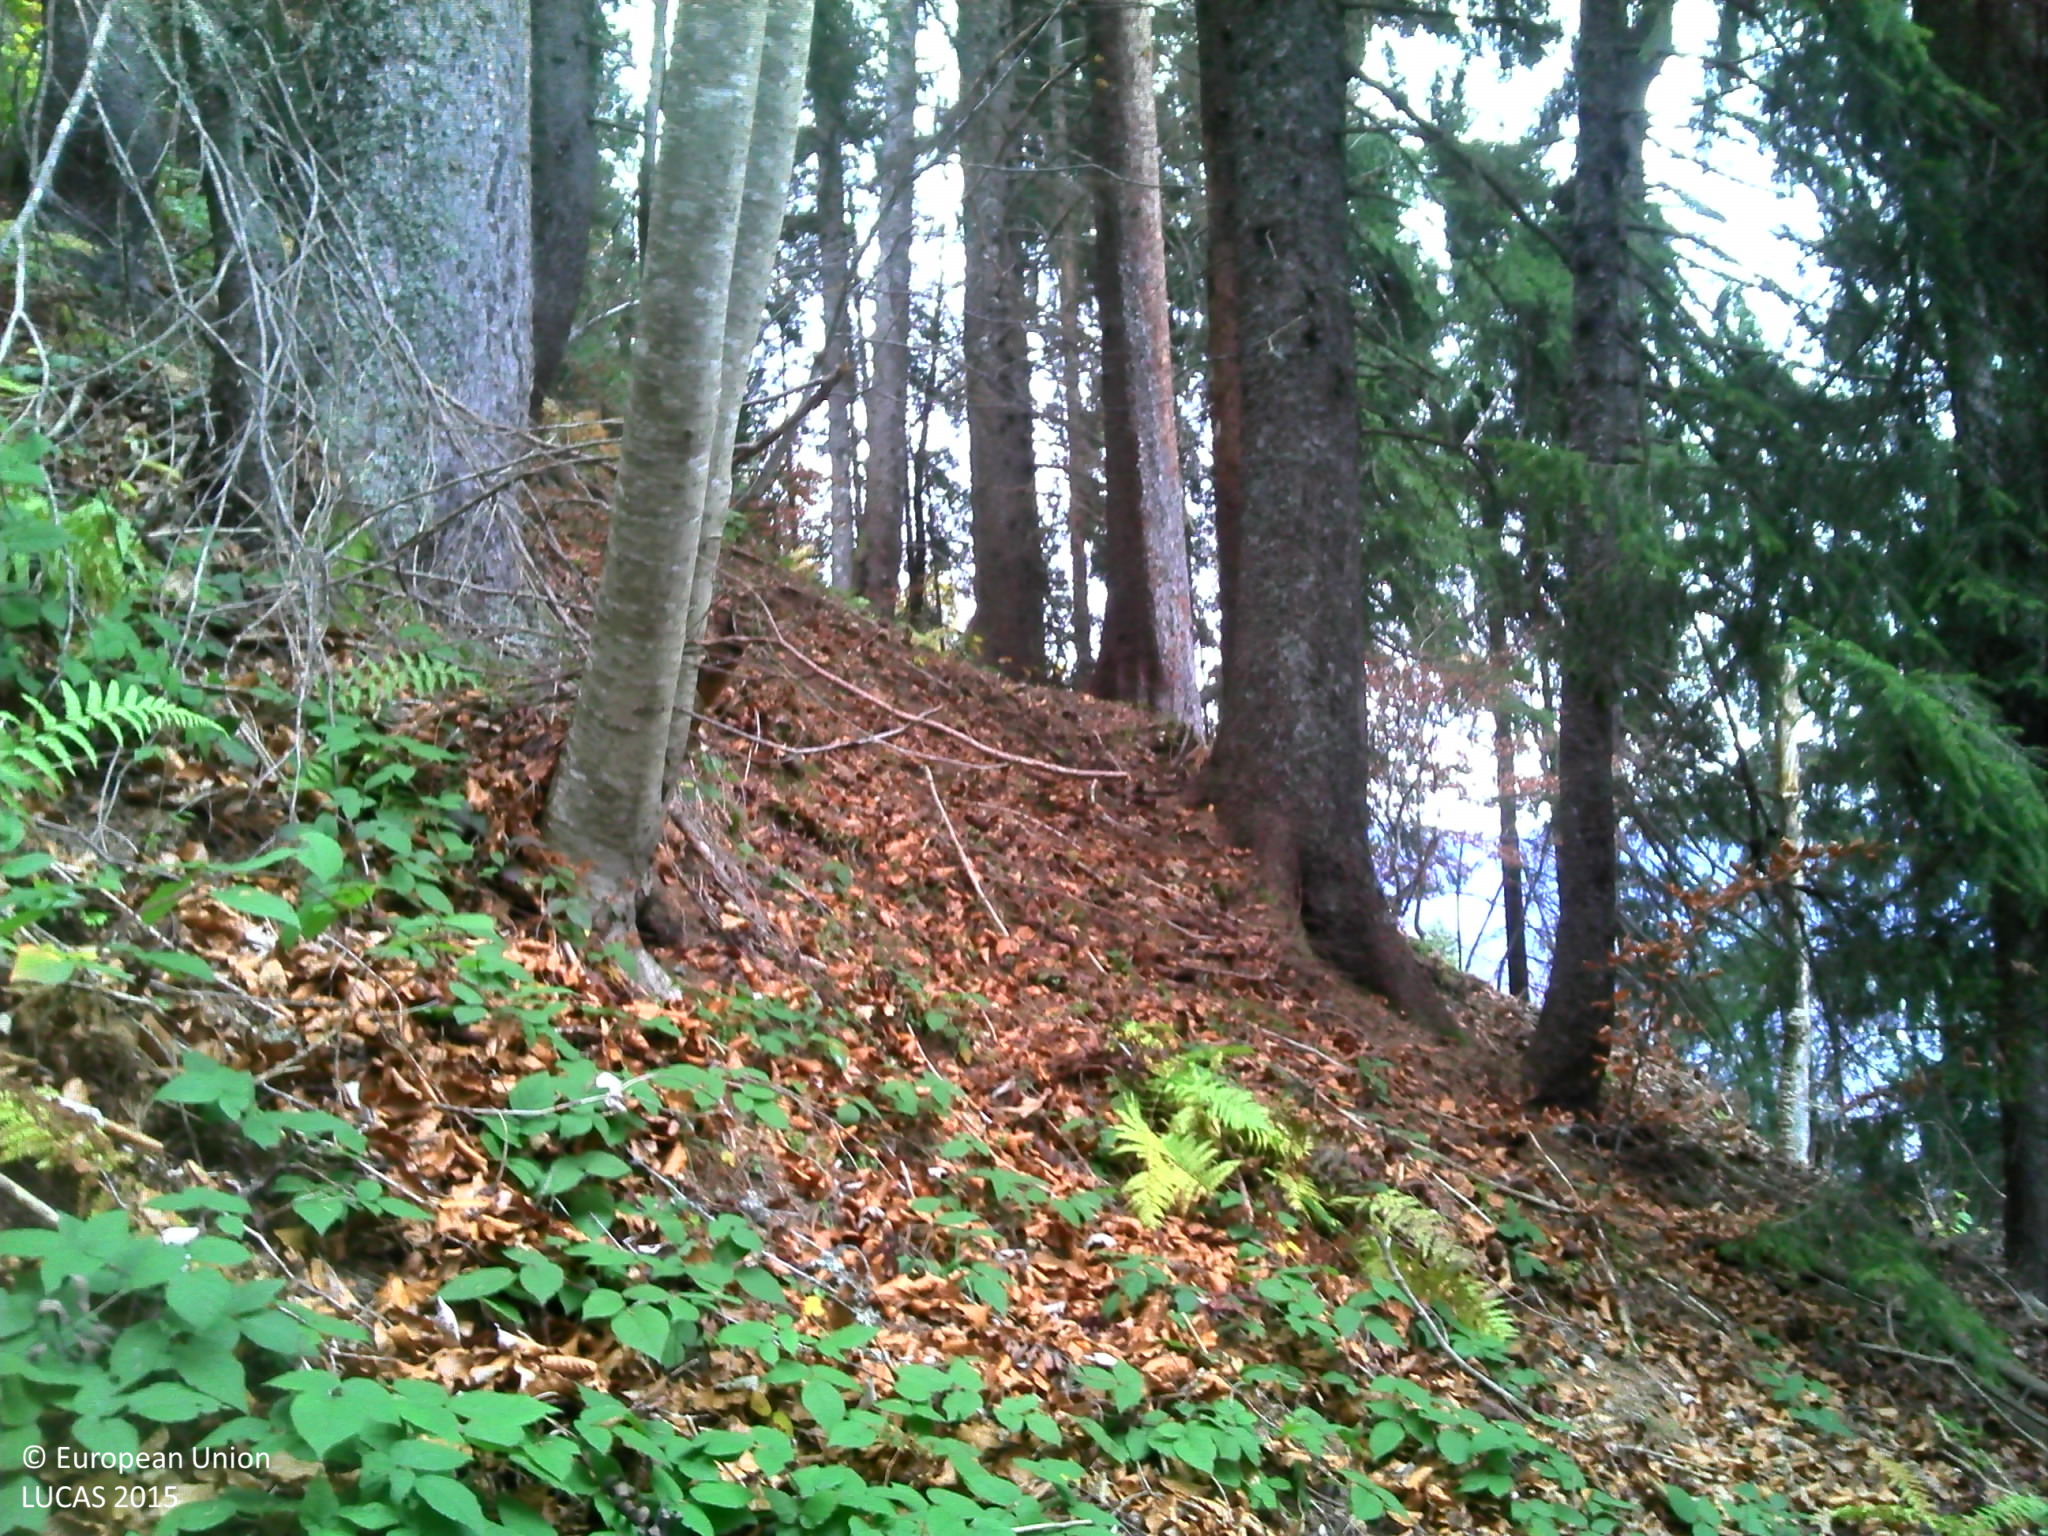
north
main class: Woodland
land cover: Spruce dominated mixed woodland
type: mountainous beech forest
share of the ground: > 75 %
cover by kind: coniferous forest trees 60 %, broadleaved forest trees 30 %, herbaceous plants 10 %
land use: Forestry
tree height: > 5 m
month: November
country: FR
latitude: 45.7880
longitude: 6.4667
